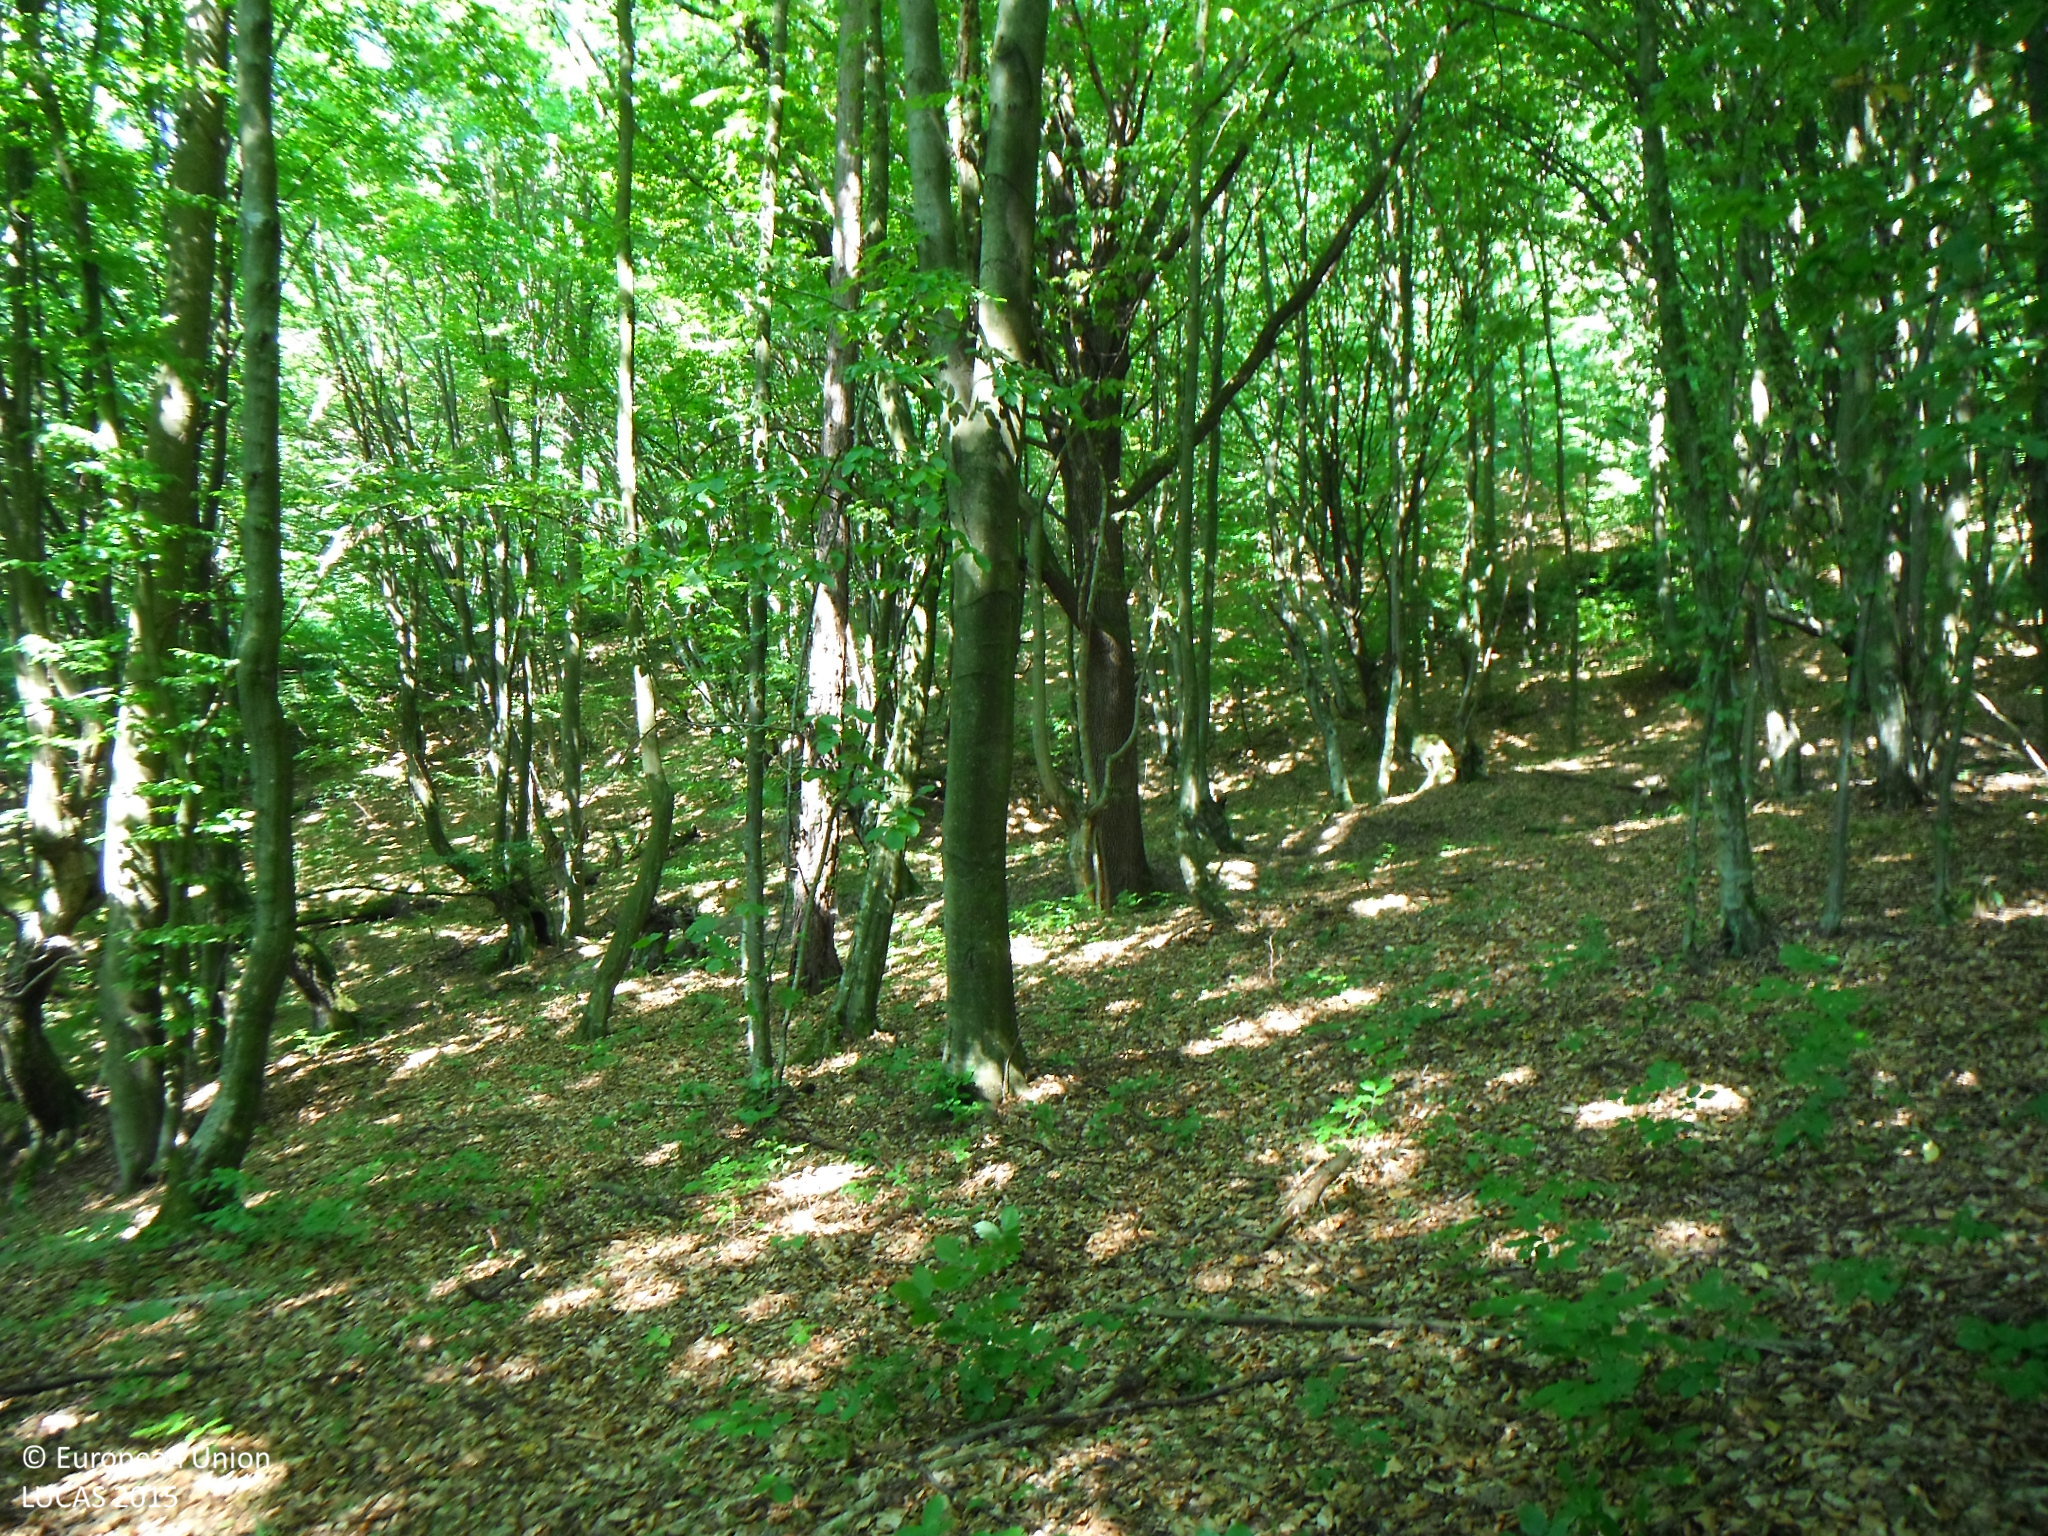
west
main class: Woodland
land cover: Broadleaved woodland
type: hemiboreal forest and nemoral coniferous forest and mixed broadleaved-coniferous forest
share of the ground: > 75 %
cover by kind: broadleaved forest trees 85 %, coniferous forest trees 15 %
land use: Forestry
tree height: > 5 m
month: August
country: SK
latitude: 49.1155
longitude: 21.9611
